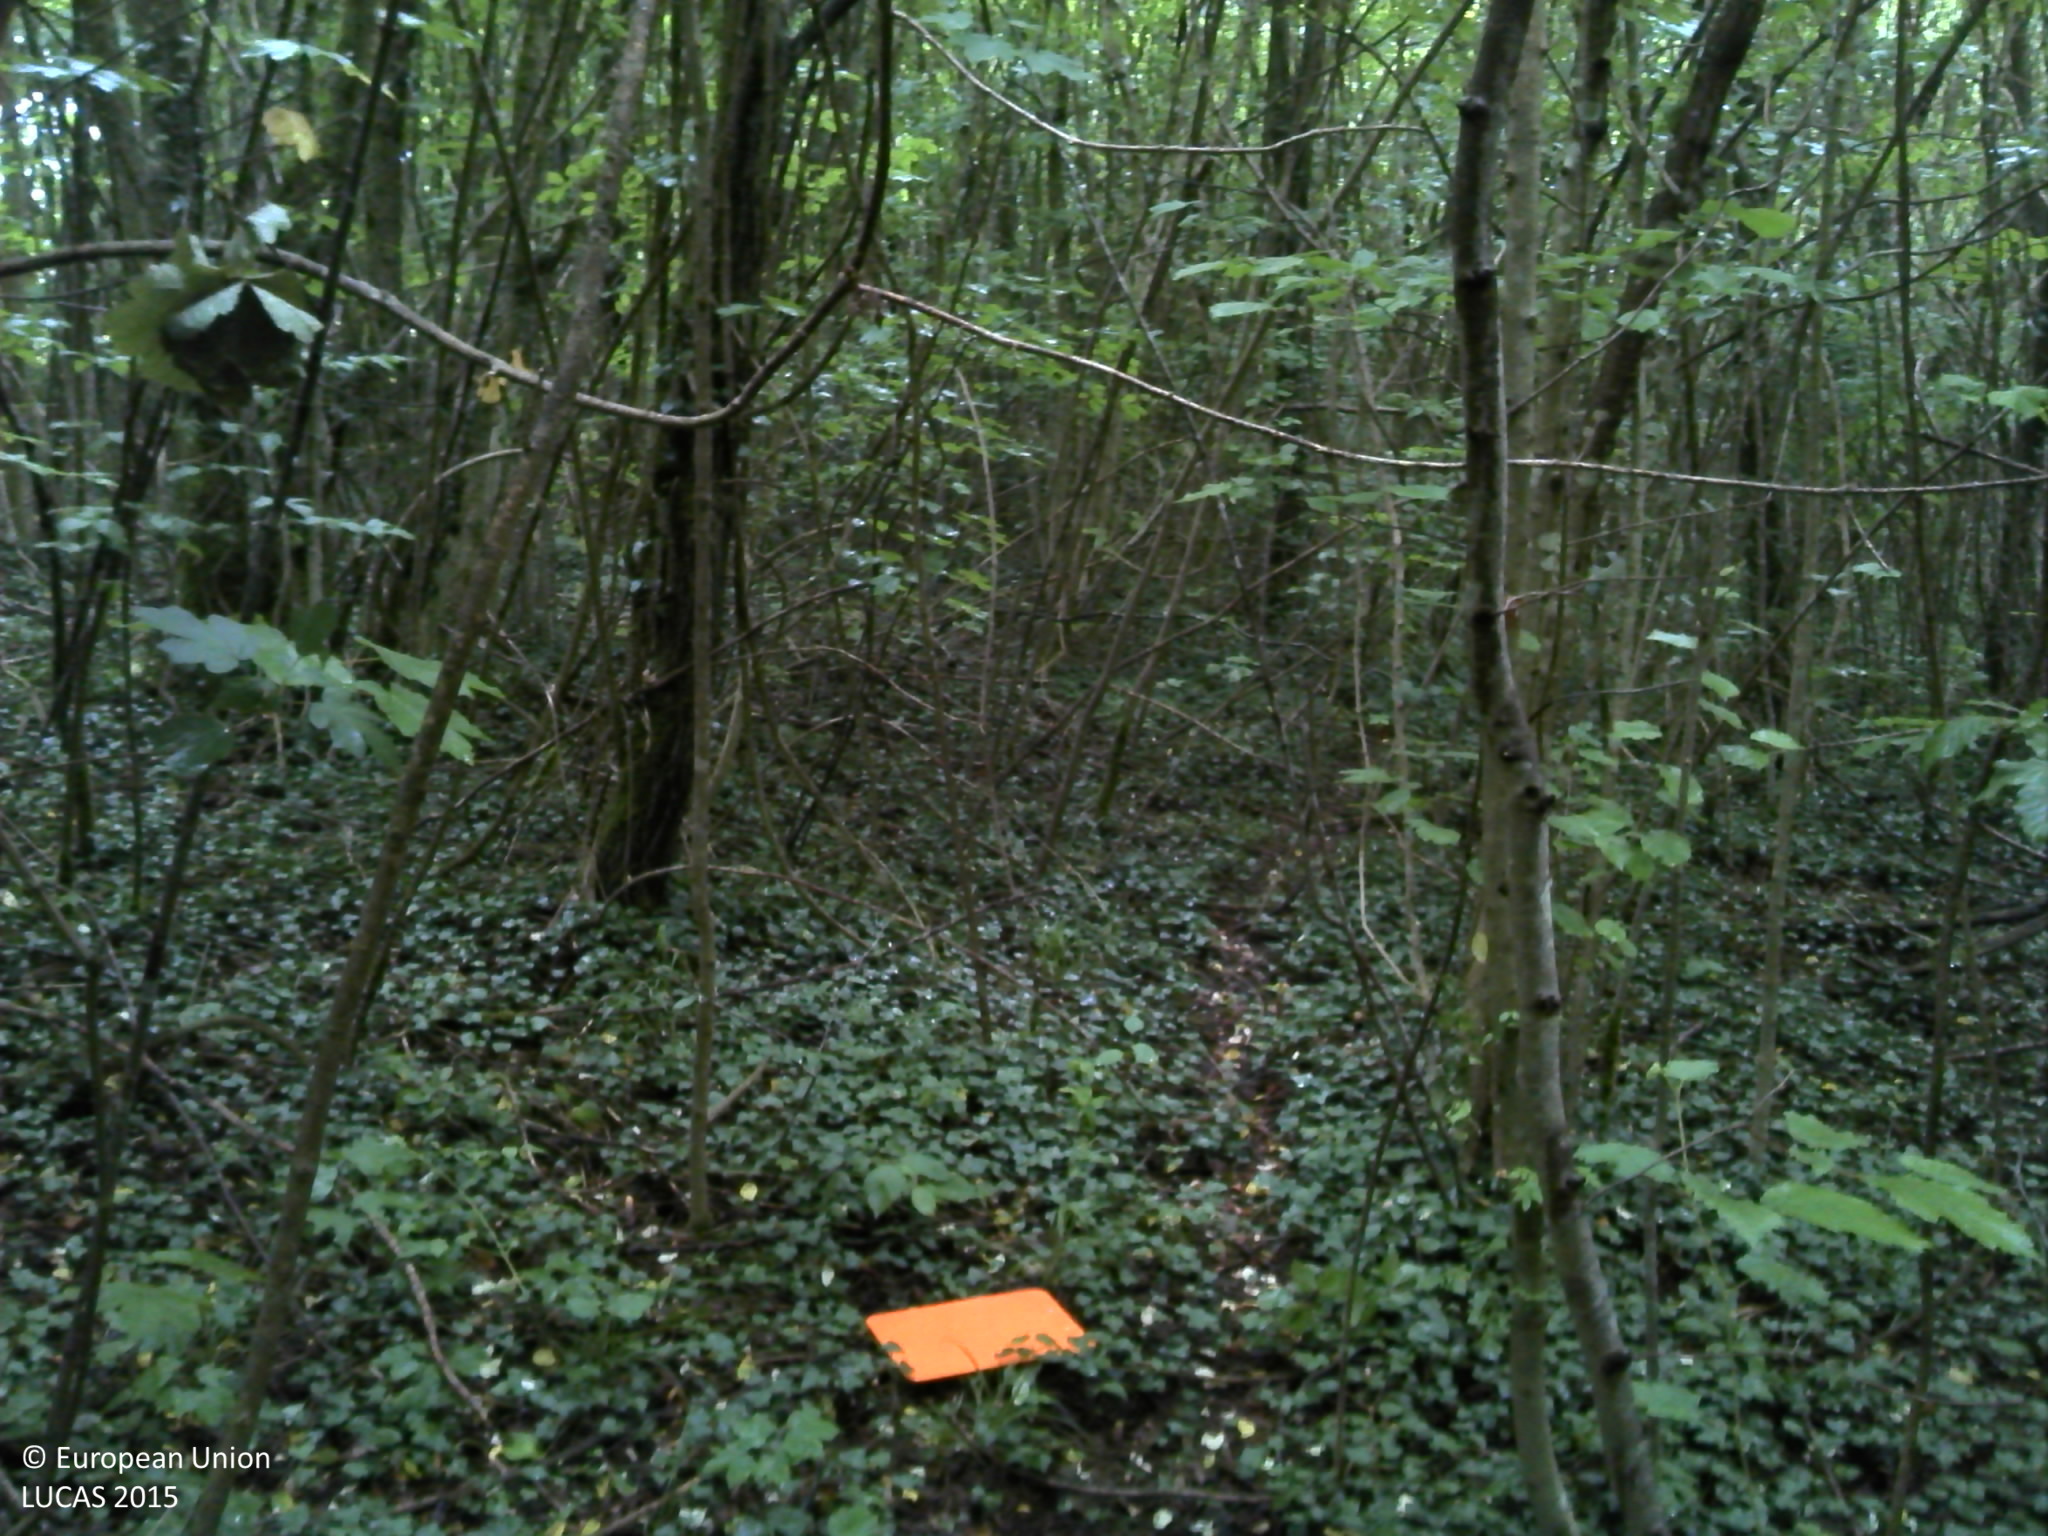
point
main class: Woodland
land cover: Broadleaved woodland
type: beech forest
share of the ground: > 75 %
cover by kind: broadleaved forest trees 75 %, herbaceous plants 15 %, consolidated bare surface 10 %
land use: Forestry
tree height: > 5 m
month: July
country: FR
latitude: 49.6794
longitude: 4.6331
